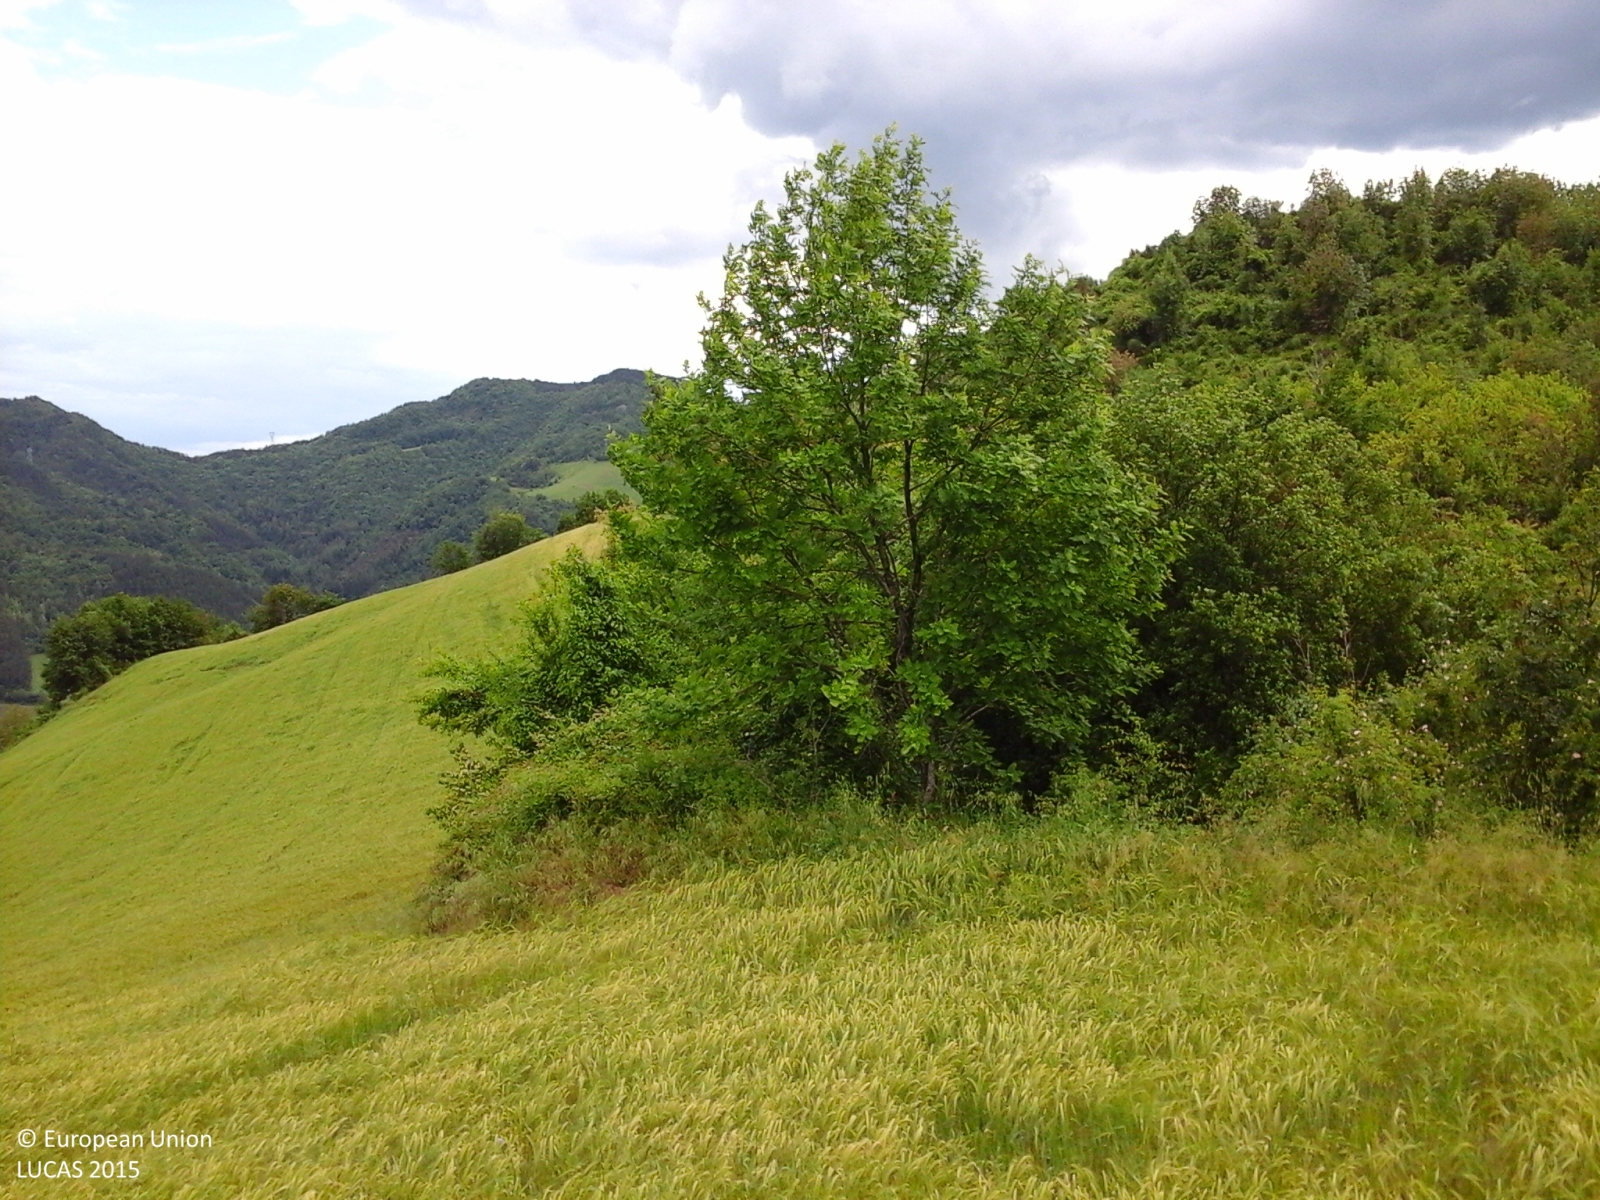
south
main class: Woodland
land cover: Broadleaved woodland
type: thermophilous deciduous forest
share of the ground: > 75 %
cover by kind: broadleaved forest trees 90 %, coniferous forest trees 10 %
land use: Forestry
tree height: > 5 m
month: May
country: IT
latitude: 44.0268
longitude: 11.8795
